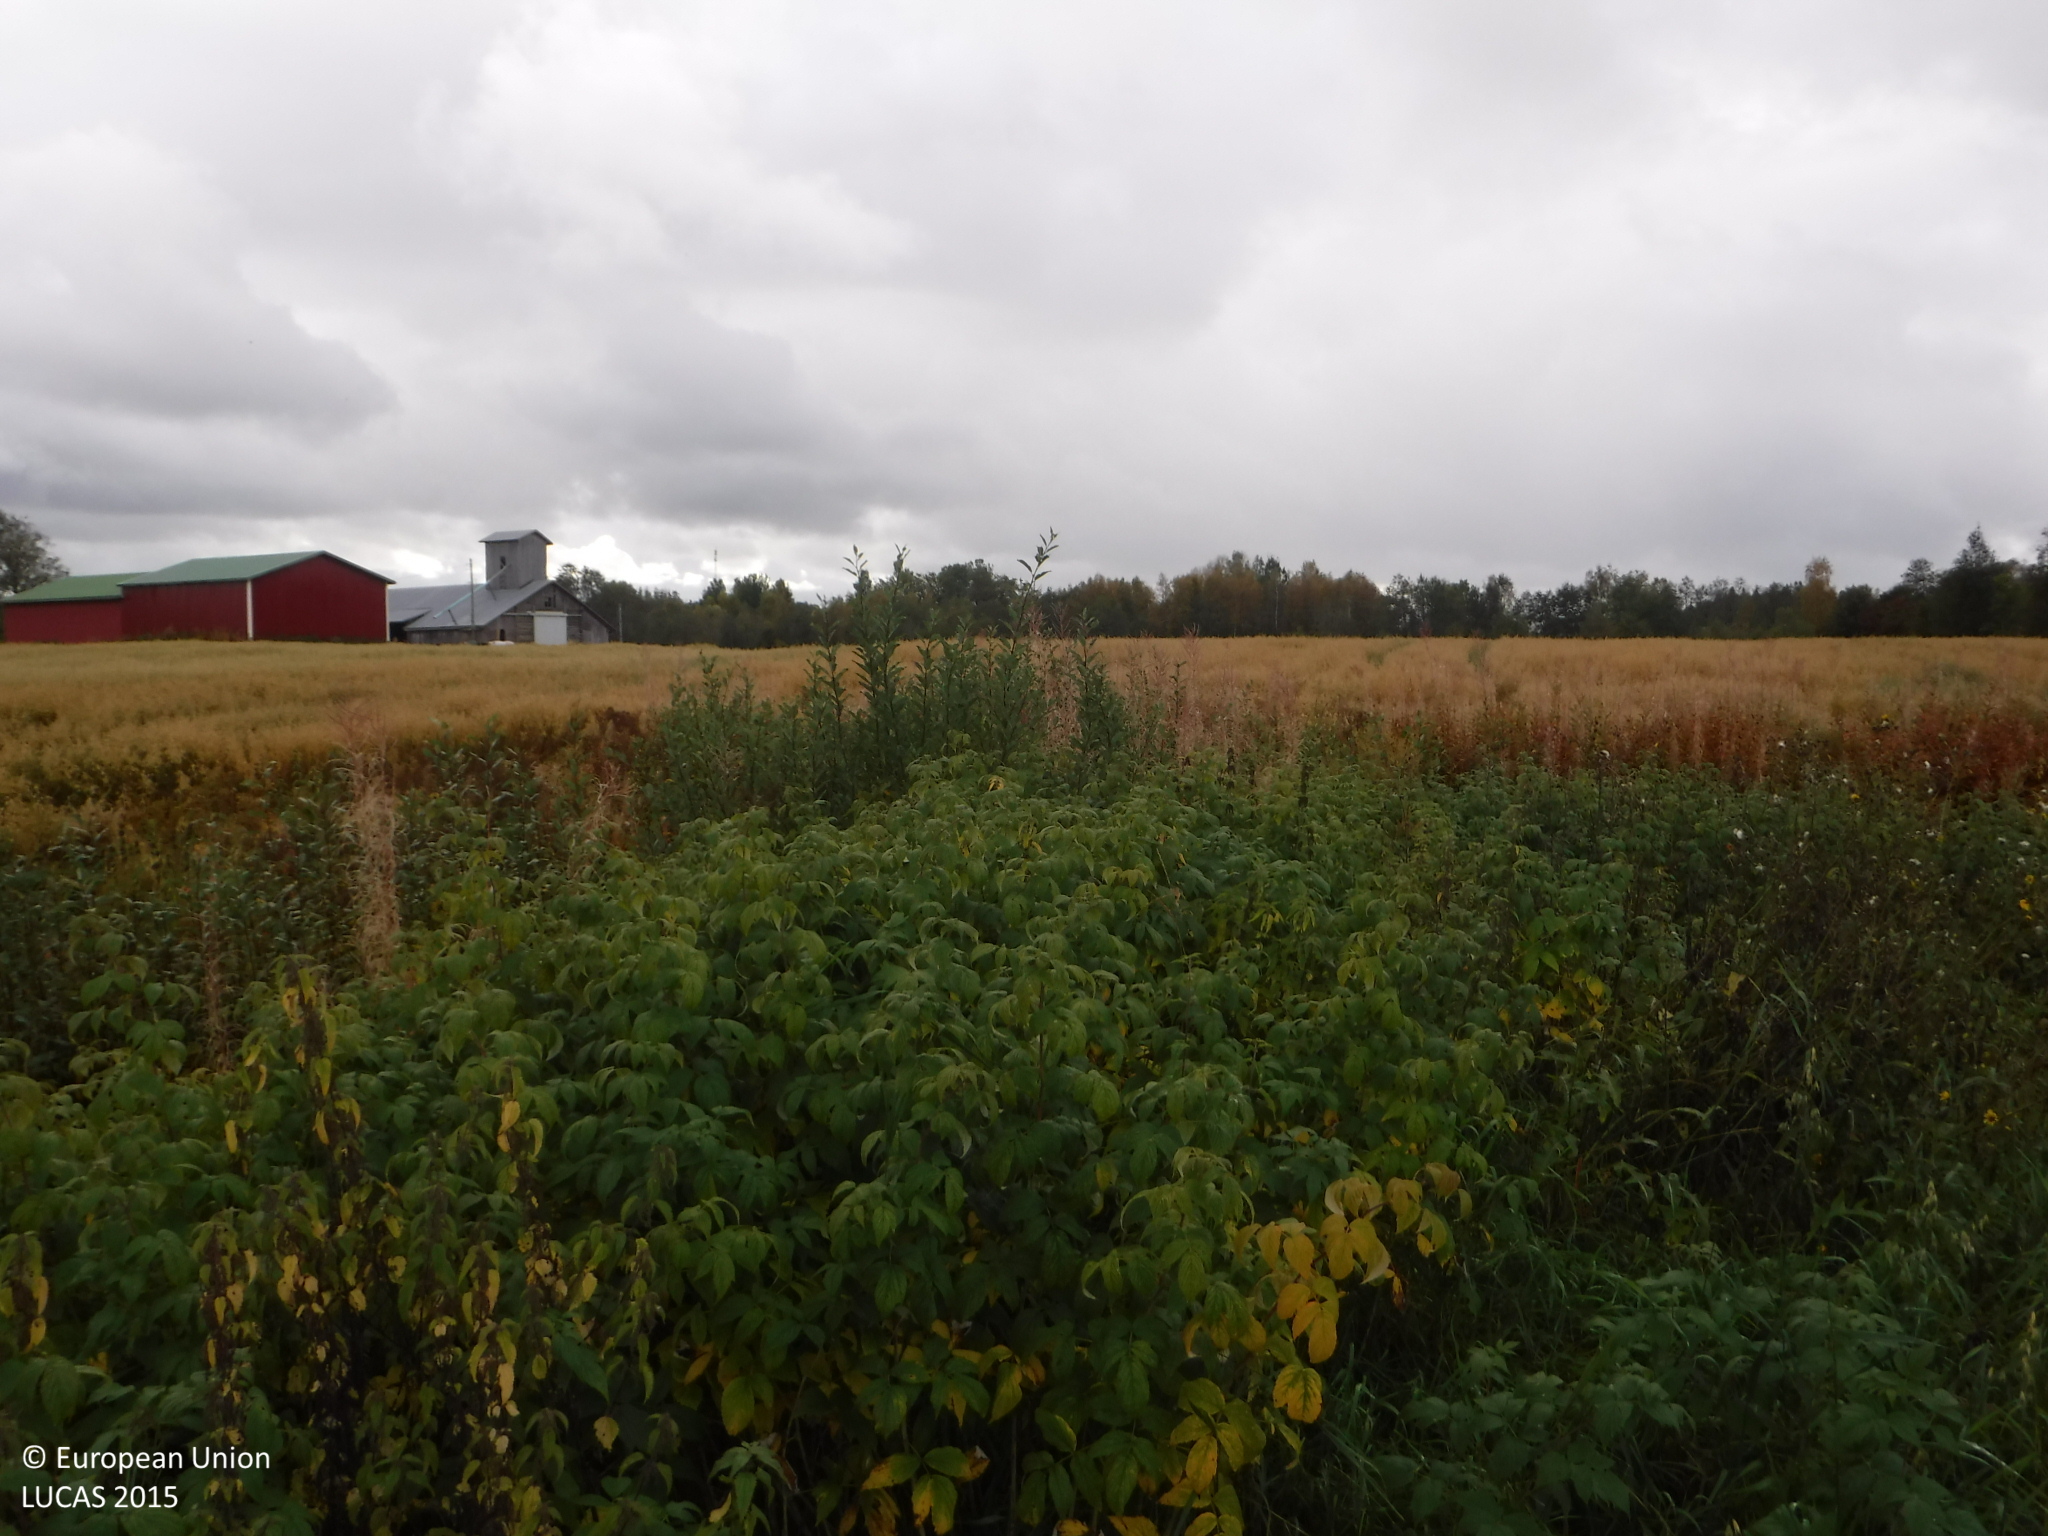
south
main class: Cropland
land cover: Oats
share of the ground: > 75 %
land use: Agriculture (excluding fallow land and kitchen gardens)
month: September
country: FI
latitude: 61.9997
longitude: 22.2572
